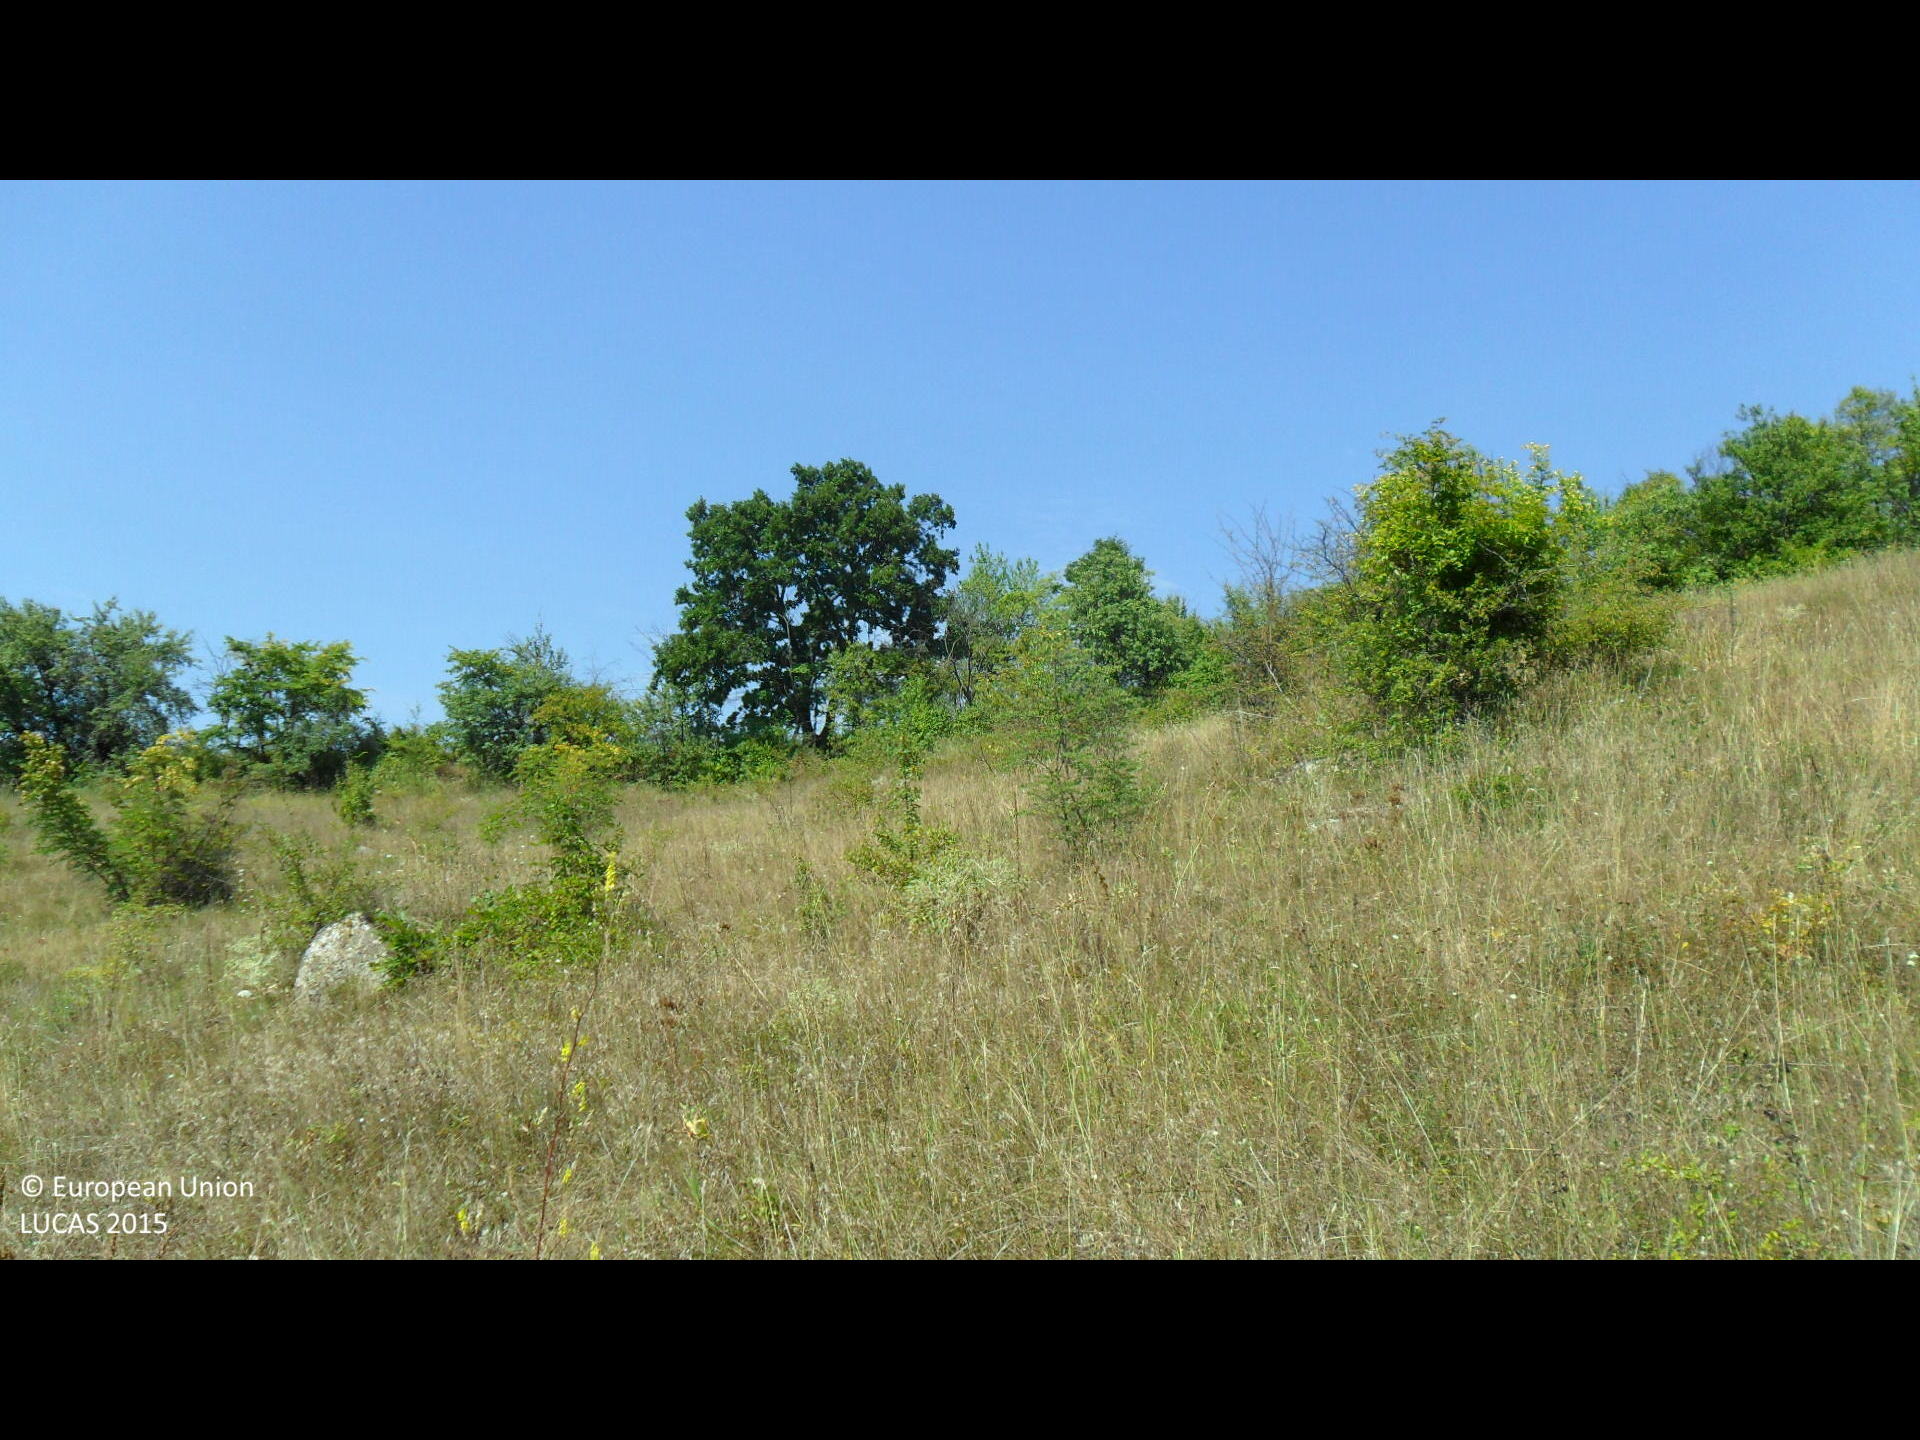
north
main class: Grassland
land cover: Grassland with sparse tree/shrub cover
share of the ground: > 75 %
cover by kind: herbaceous plants 90 %, broadleaved forest trees 5 %, shrubs 5 %
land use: Agriculture (excluding fallow land and kitchen gardens)
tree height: < 5 m
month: August
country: BG
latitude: 43.4785
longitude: 26.1557
